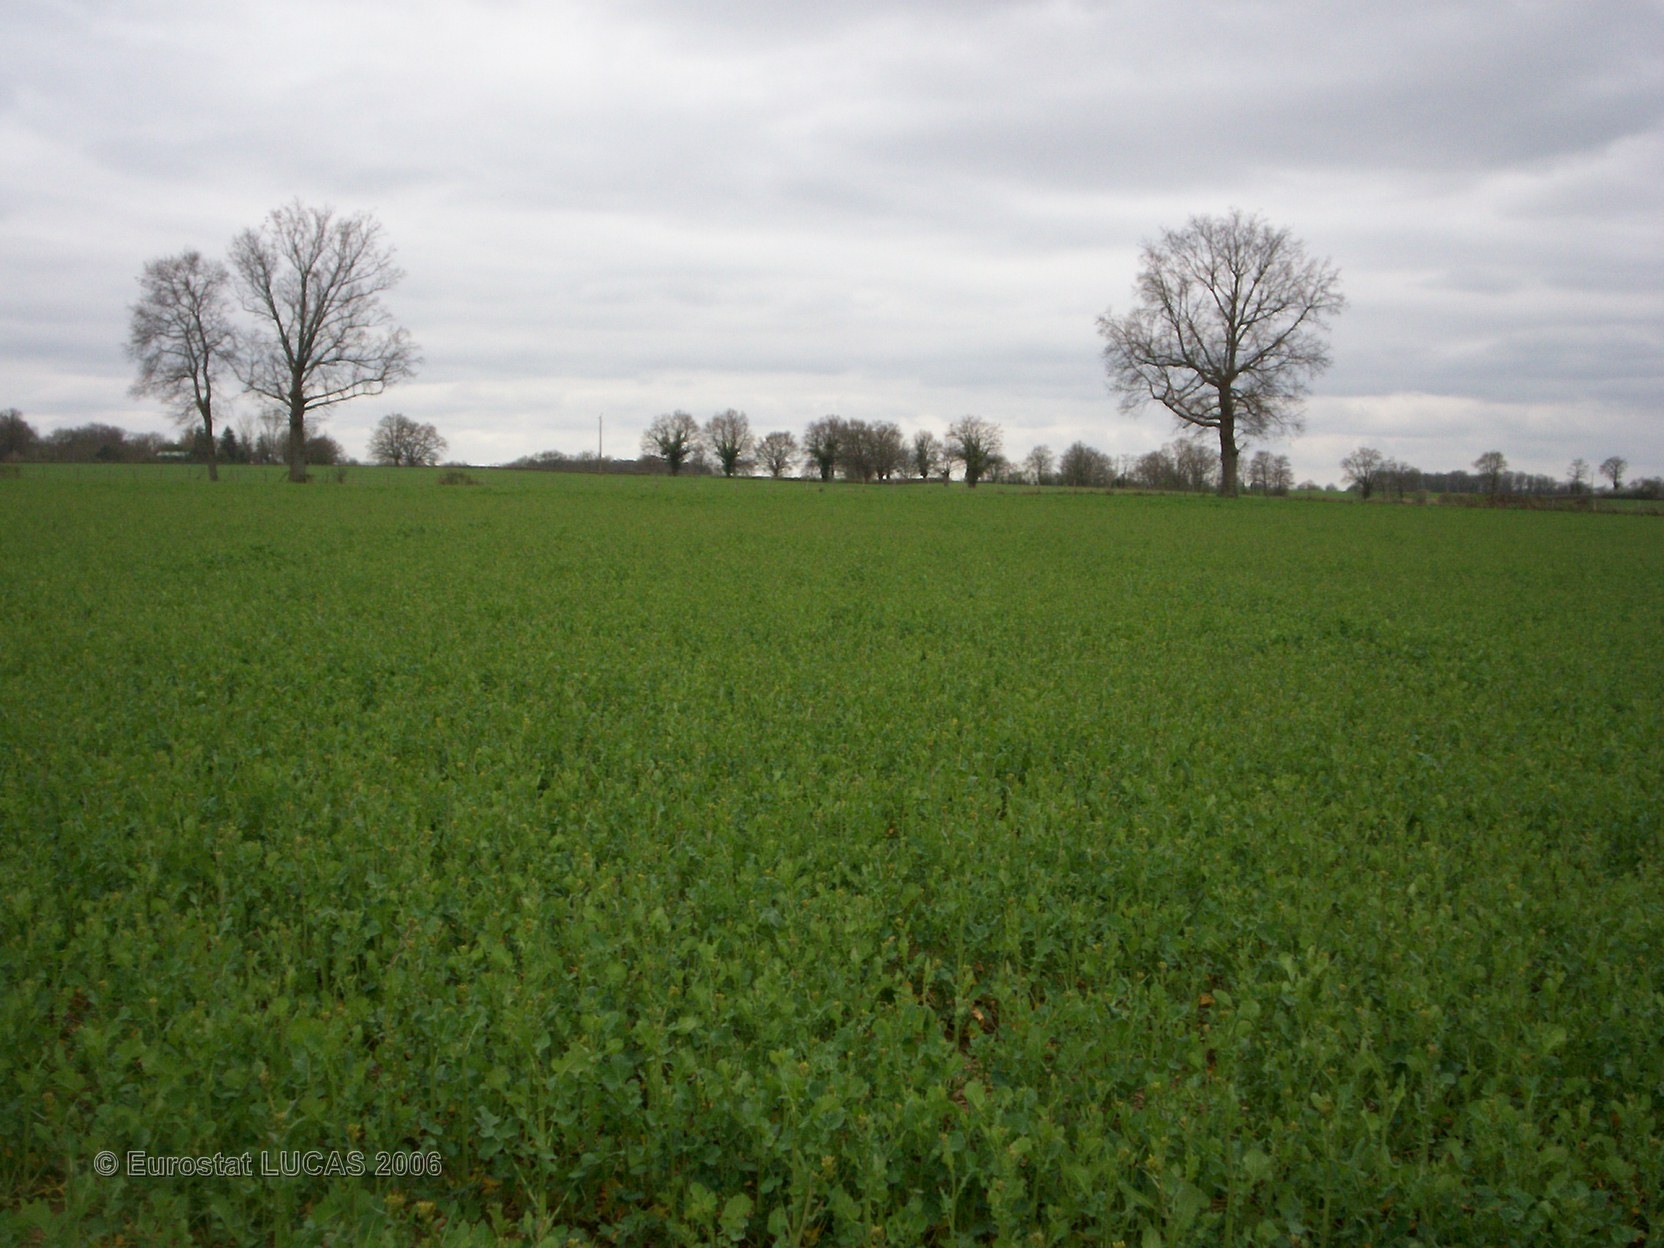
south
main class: Cropland
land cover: Rape and turnip rape
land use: Agriculture (excluding fallow land and kitchen gardens)
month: April
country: FR
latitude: 46.7035
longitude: 3.0517
